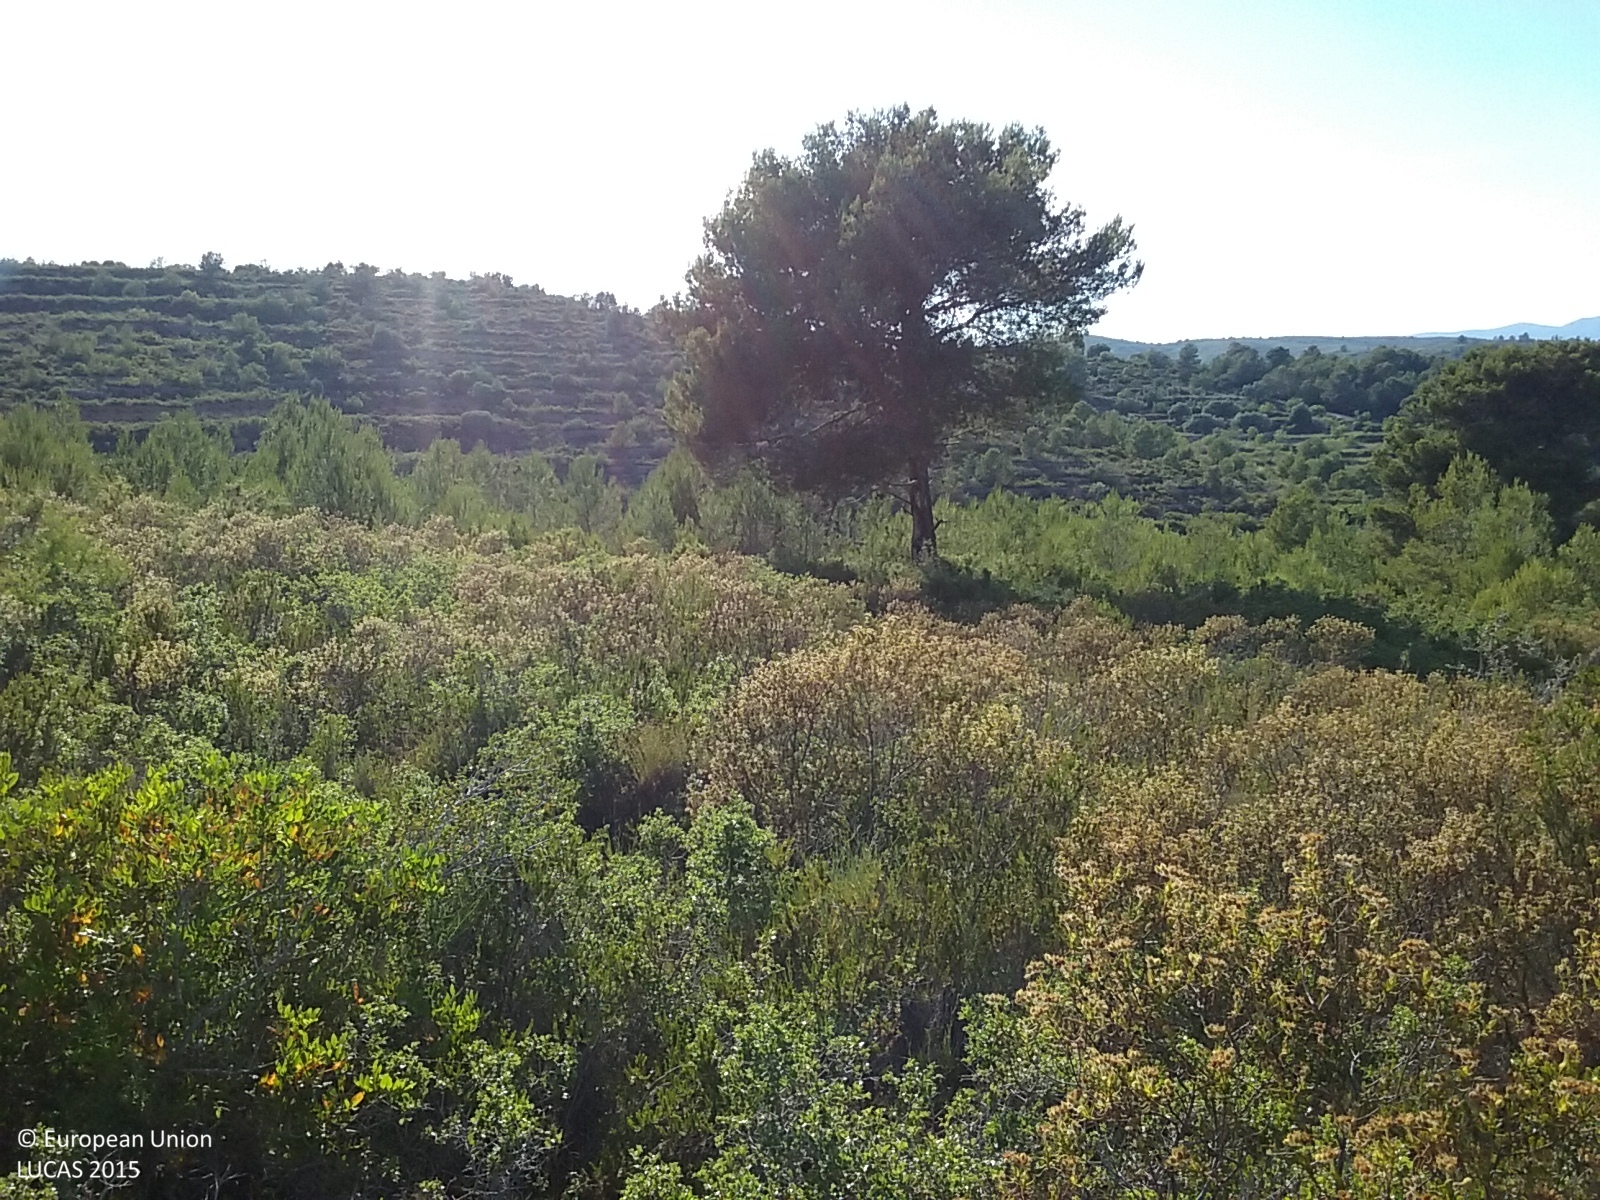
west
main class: Shrubland
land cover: Shrubland with sparse tree cover
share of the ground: > 75 %
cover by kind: shrubs 90 %, coniferous forest trees 5 %, herbaceous plants 5 %
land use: Semi-natural and natural areas not in use
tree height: < 5 m
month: June
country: ES
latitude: 40.1864
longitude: 0.1200
